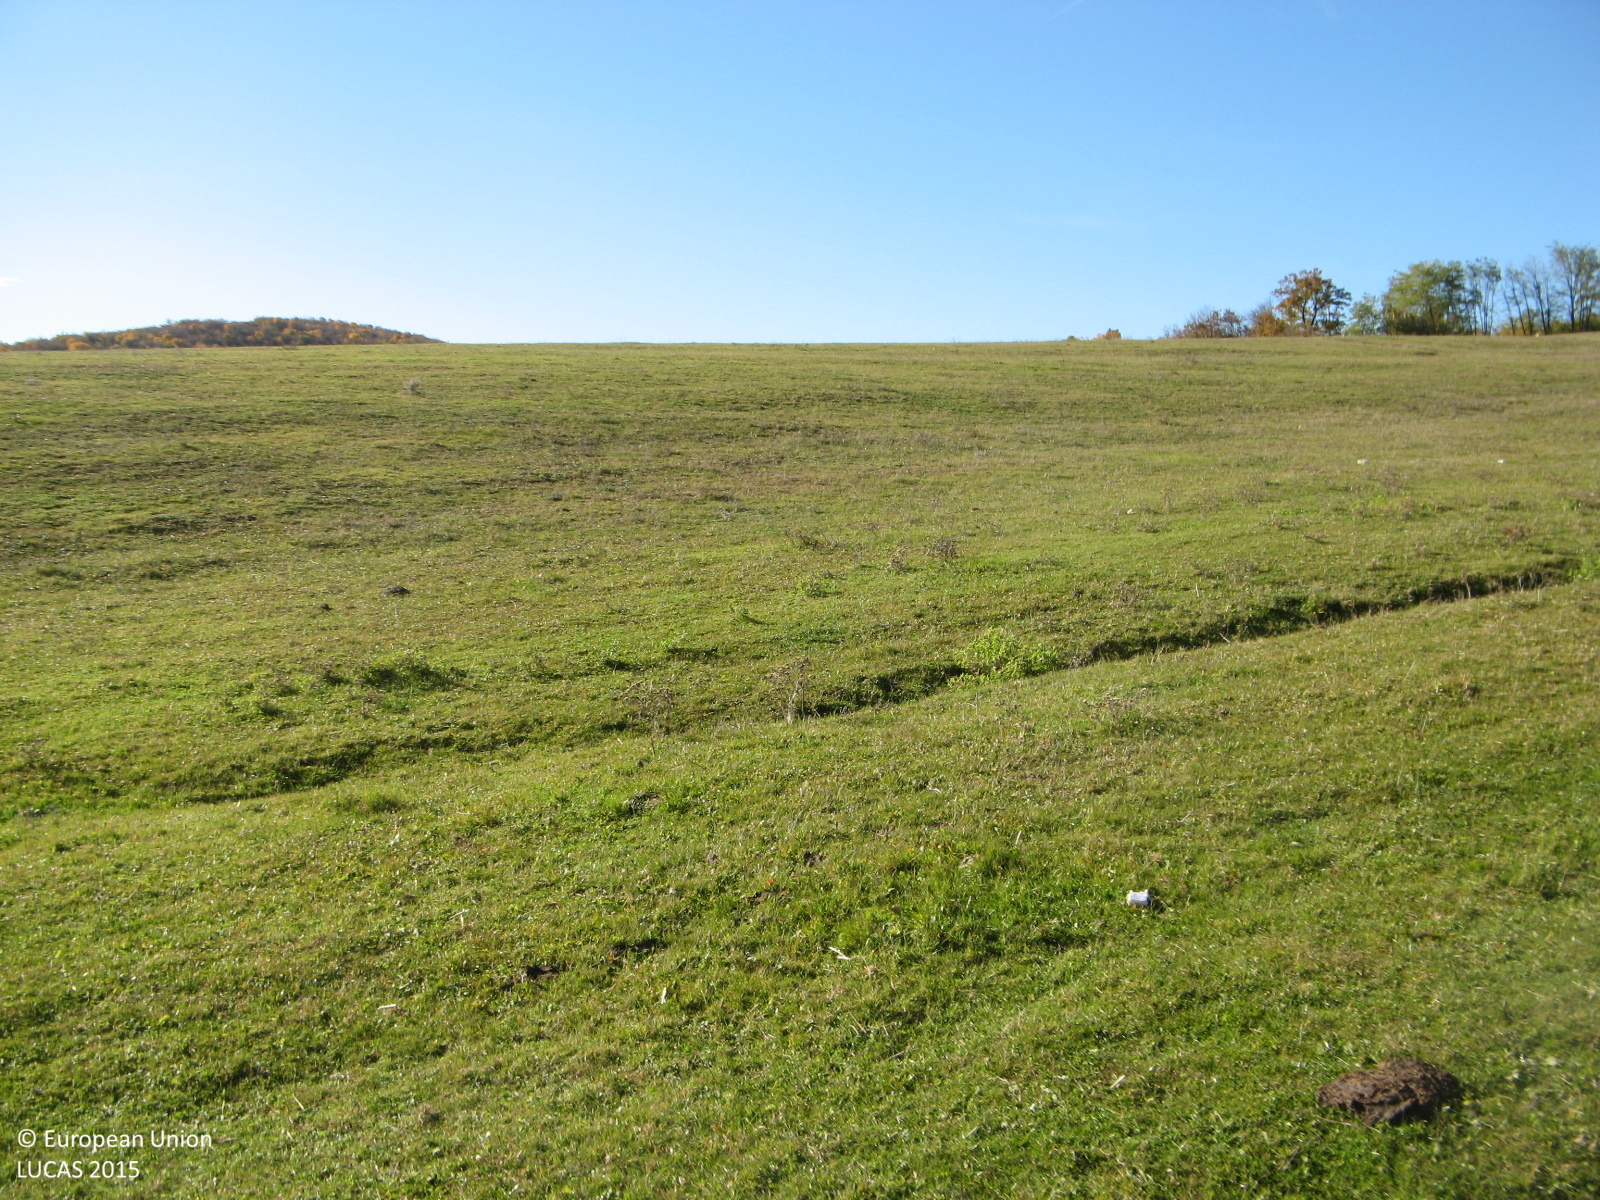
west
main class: Grassland
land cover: Grassland without tree/shrub cover
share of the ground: > 75 %
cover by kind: herbaceous plants 100 %
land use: Agriculture (excluding fallow land and kitchen gardens)
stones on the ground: < 10 %
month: November
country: BG
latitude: 41.7626
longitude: 25.3948
